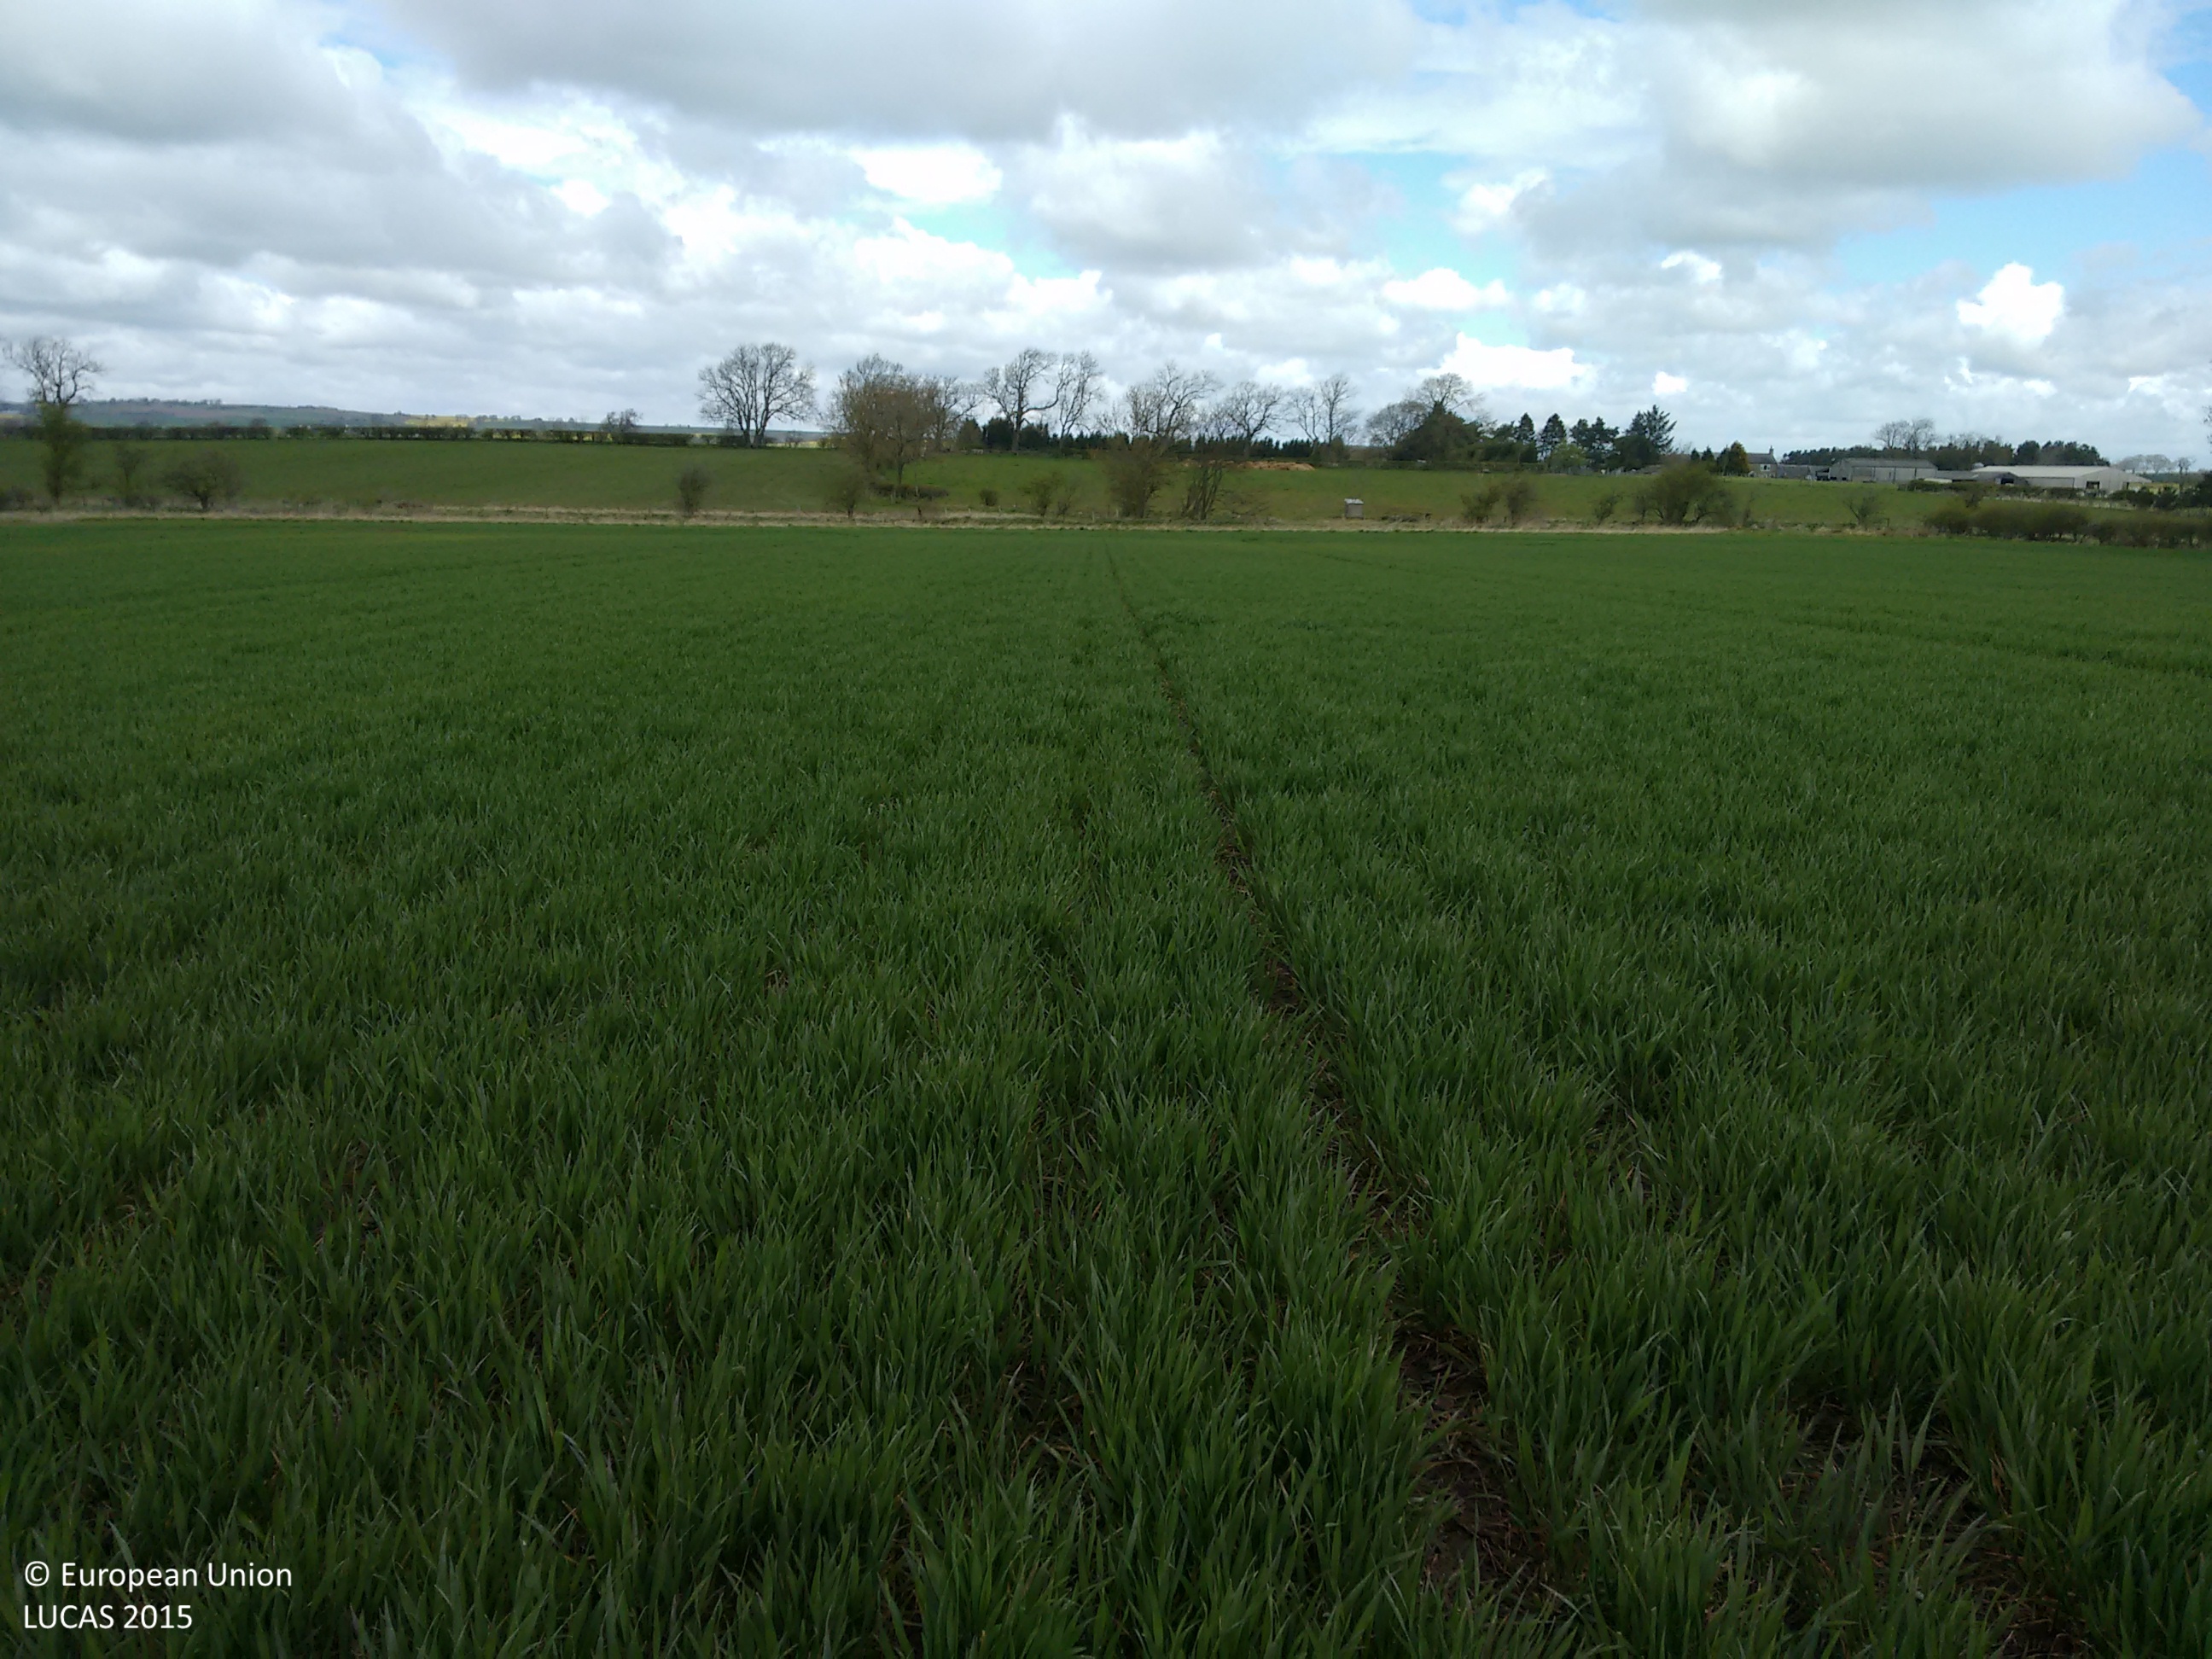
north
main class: Cropland
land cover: Common wheat
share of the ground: > 75 %
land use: Agriculture (excluding fallow land and kitchen gardens)
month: April
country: GB
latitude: 55.0316
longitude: -1.8964
